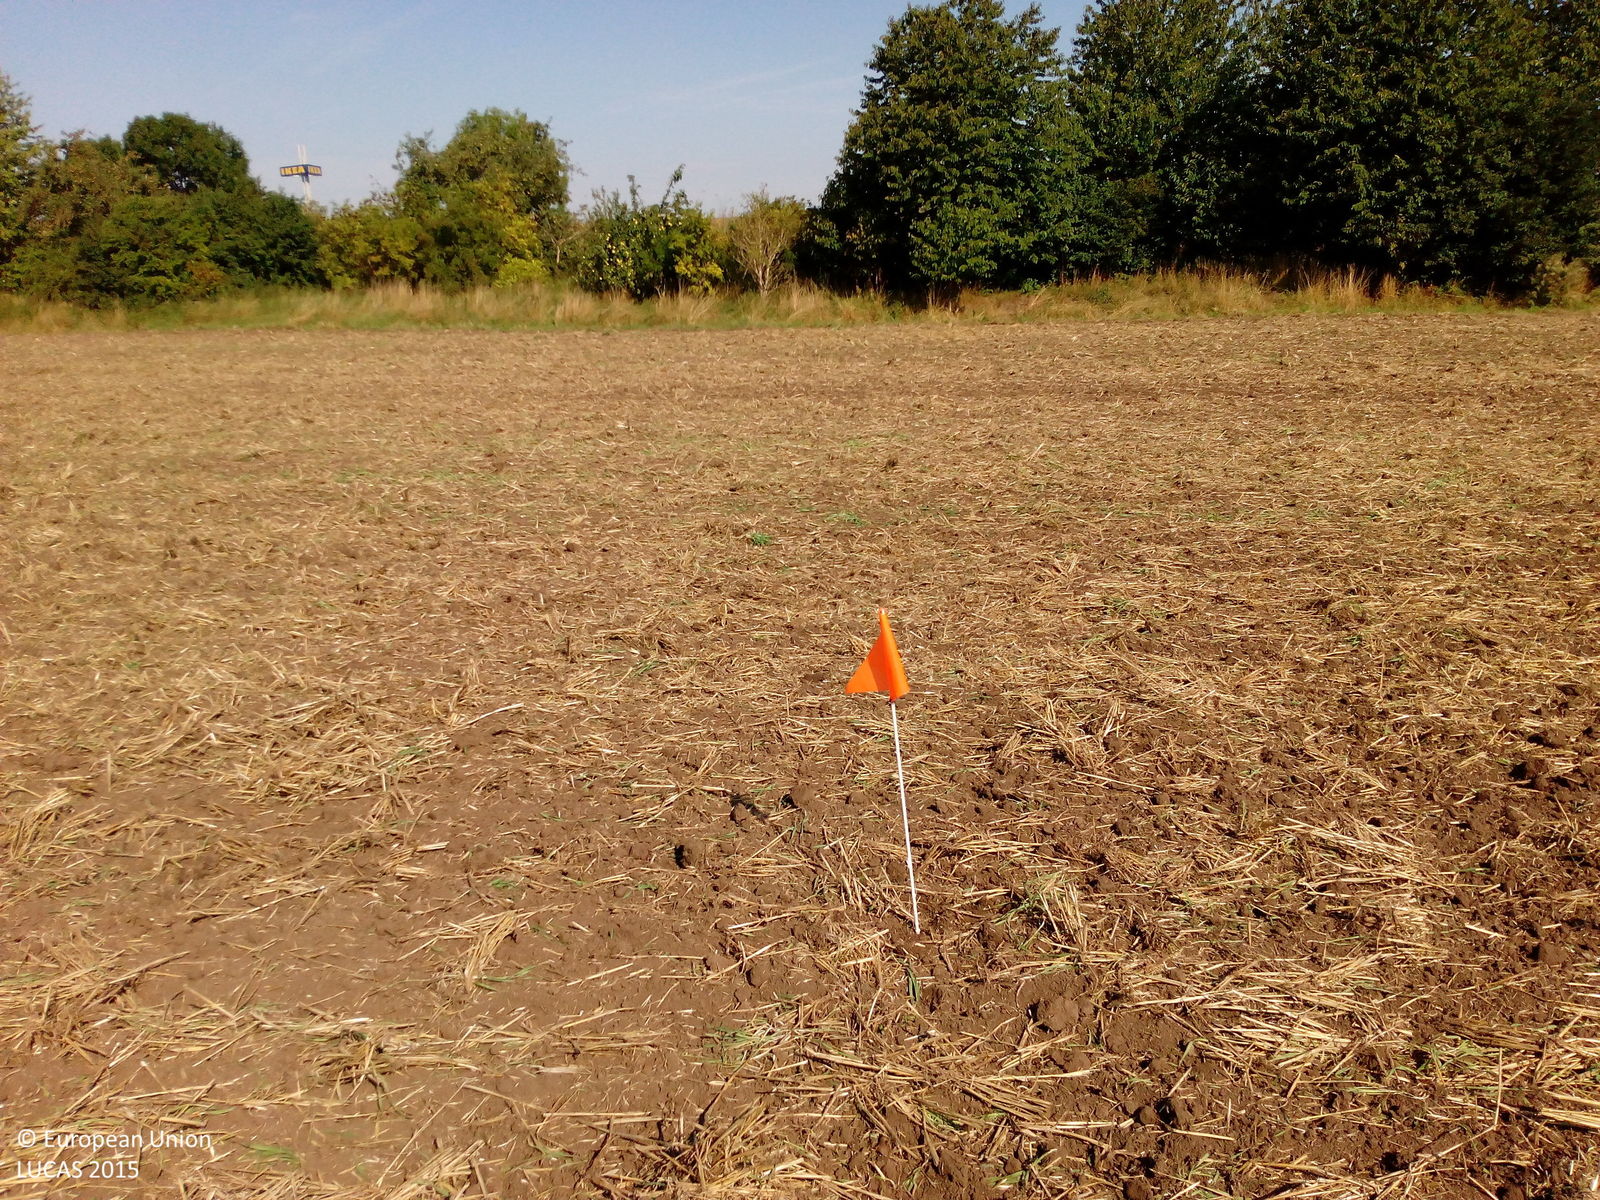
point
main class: Cropland
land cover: Barley
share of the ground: < 10 %
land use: Agriculture (excluding fallow land and kitchen gardens)
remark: Harvested field
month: August
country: DE
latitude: 50.9534
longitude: 10.9535
